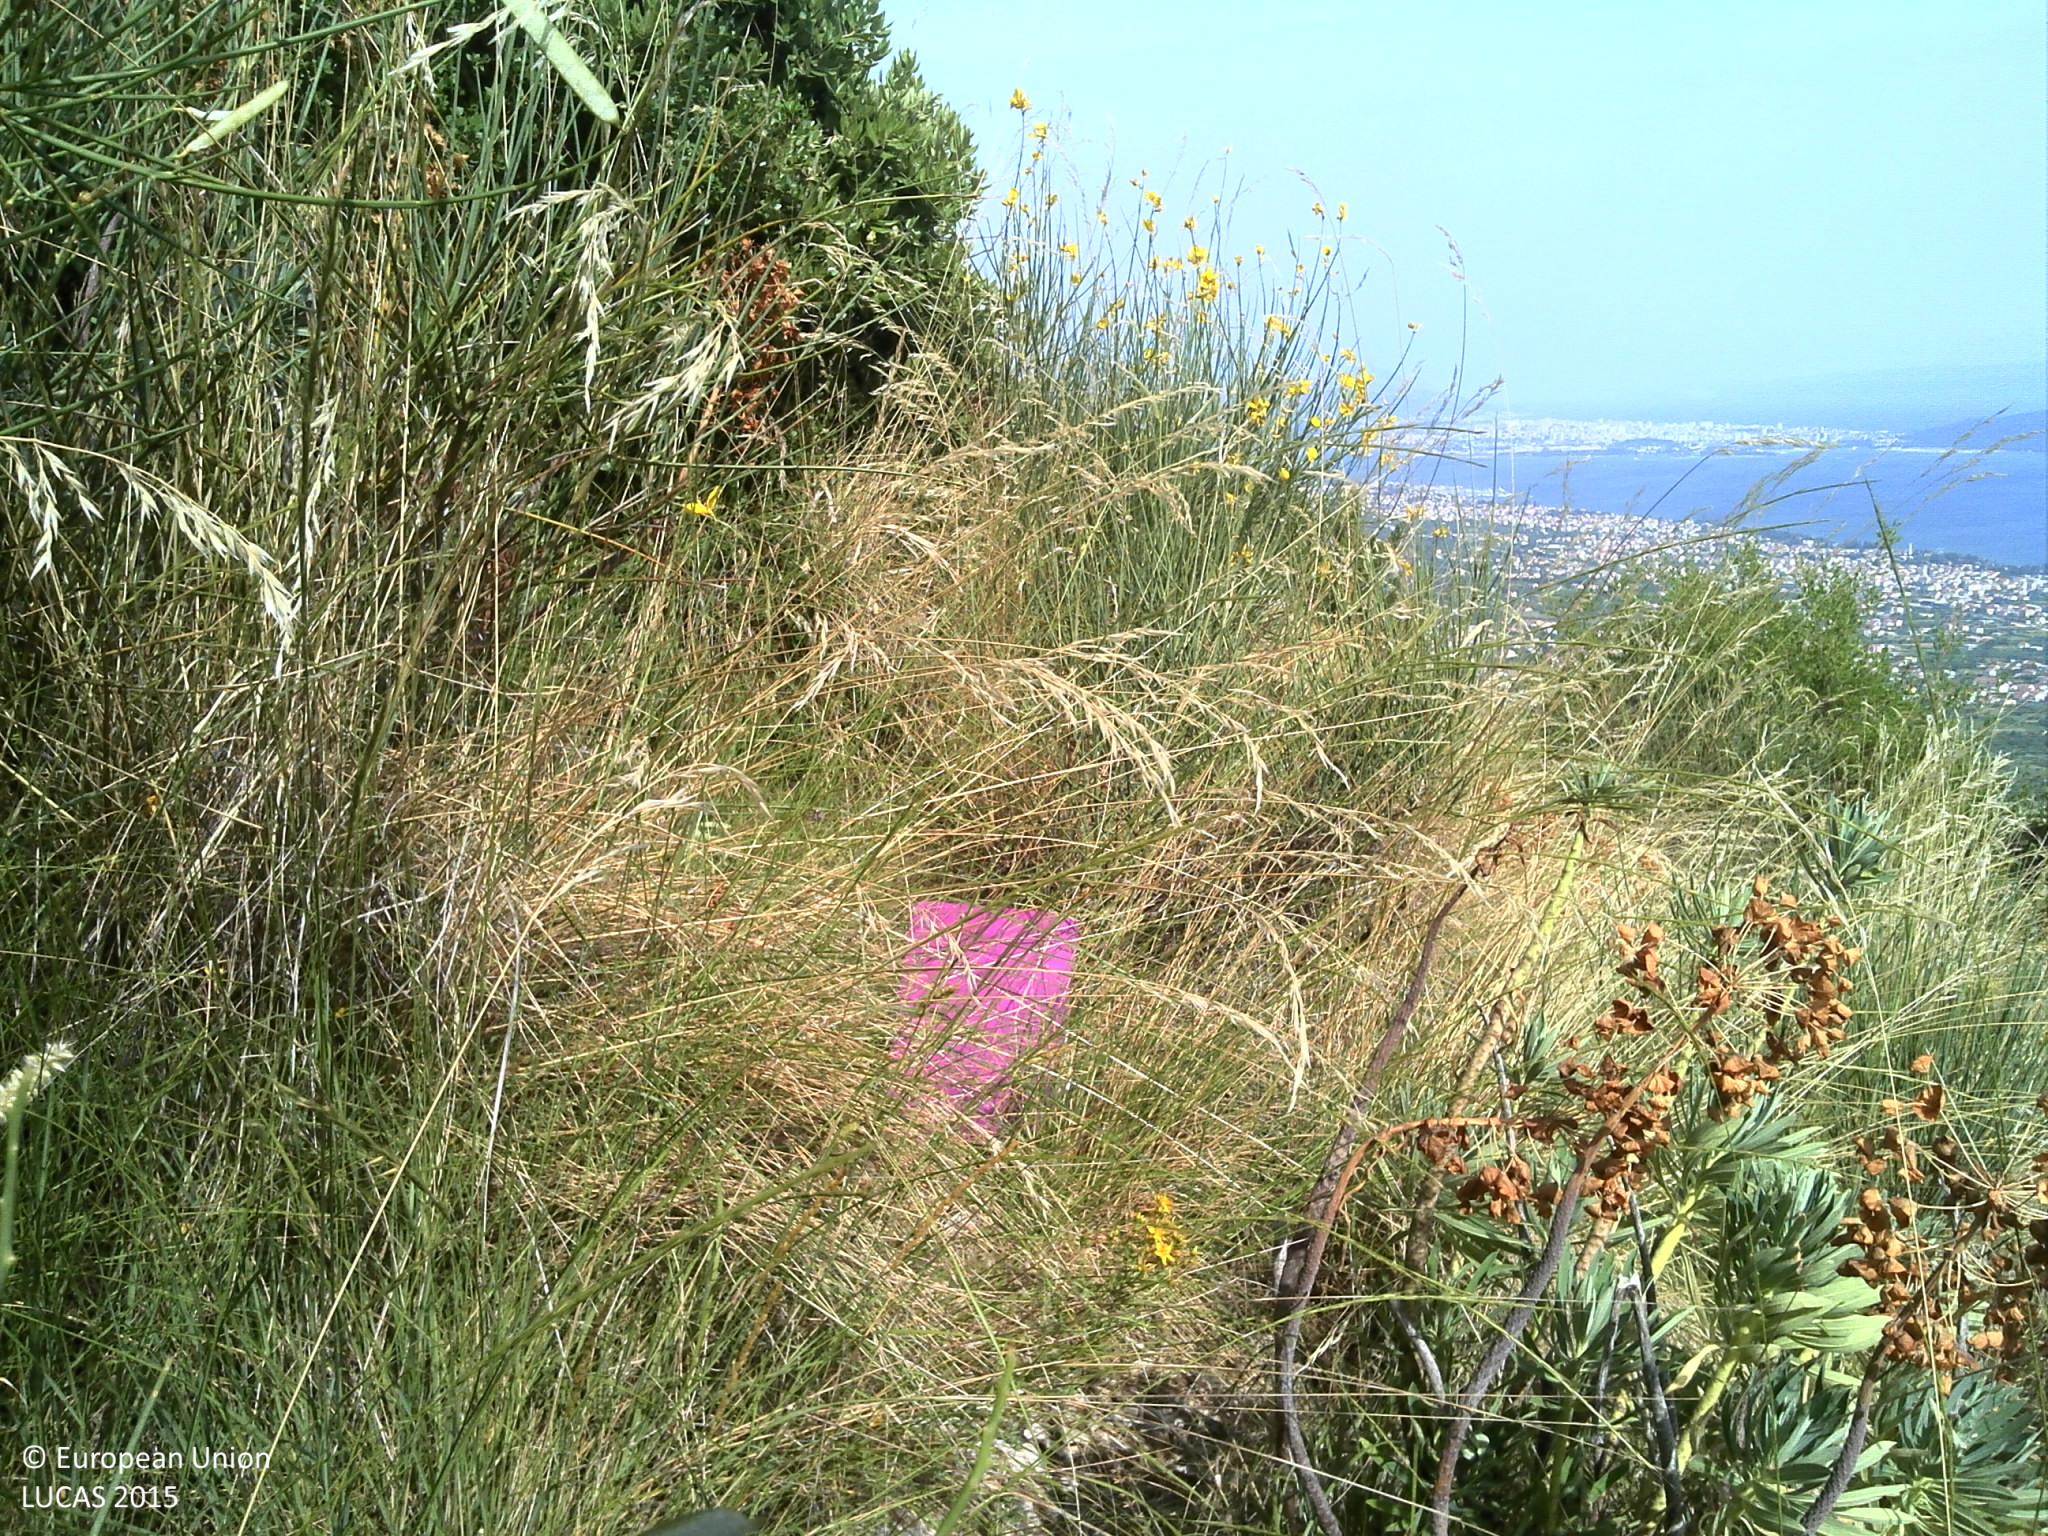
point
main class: Shrubland
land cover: Shrubland with sparse tree cover
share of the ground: > 75 %
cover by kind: shrubs 75 %, herbaceous plants 10 %, broadleaved forest trees 5 %, consolidated bare surface 5 %, unconsolidated bare surface 5 %
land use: Semi-natural and natural areas not in use
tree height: < 5 m
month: June
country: HR
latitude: 43.5790
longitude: 16.3189
